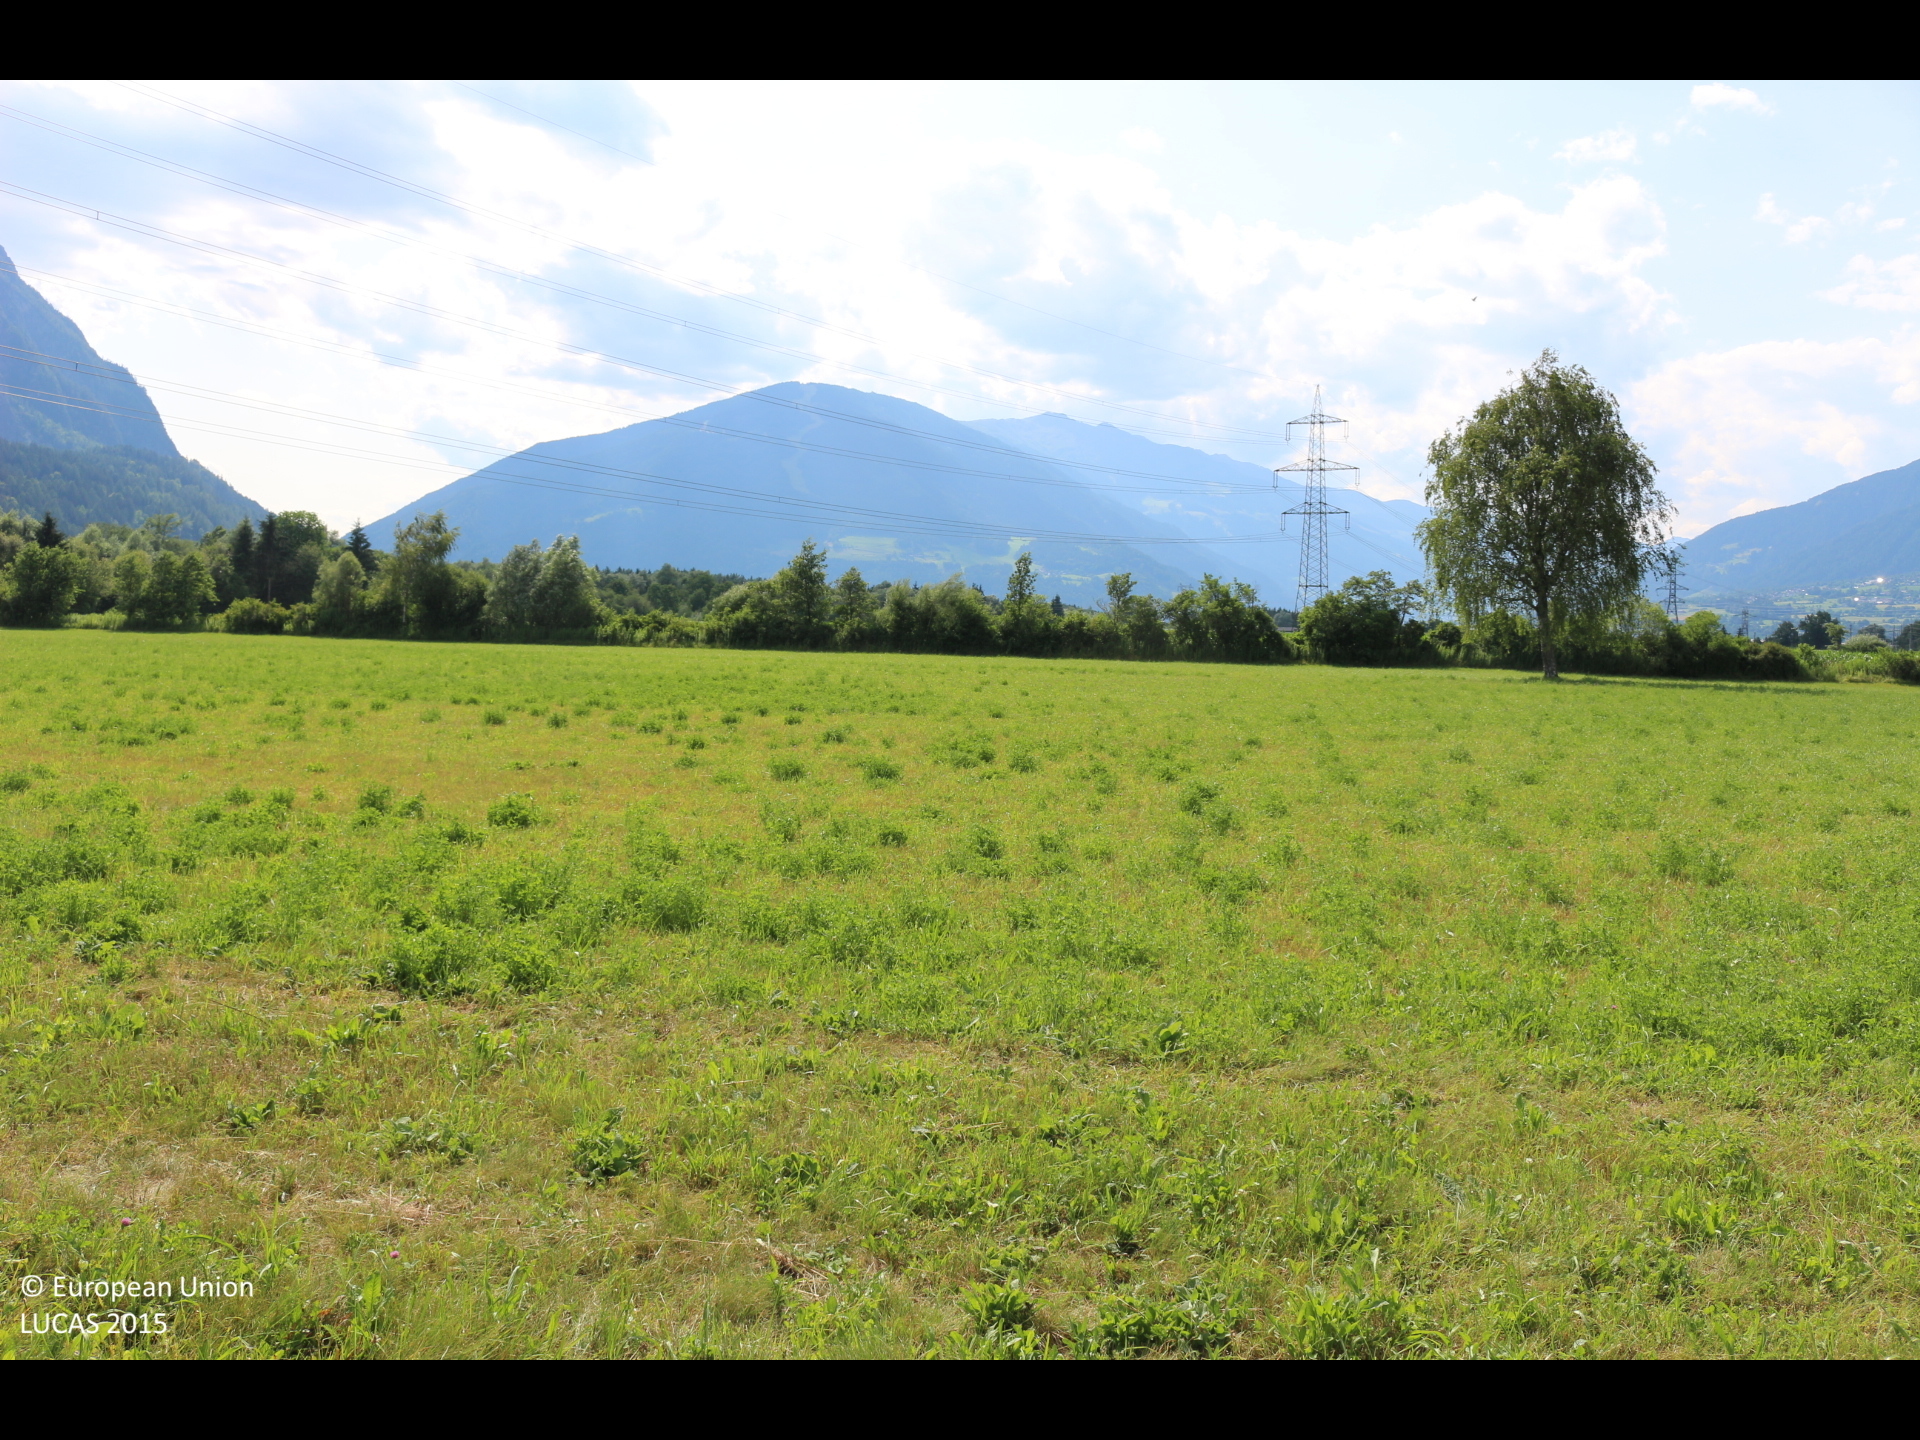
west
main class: Cropland
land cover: Maize
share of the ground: > 75 %
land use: Agriculture (excluding fallow land and kitchen gardens)
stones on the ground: < 10 %
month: July
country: AT
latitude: 46.8187
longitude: 12.8155
